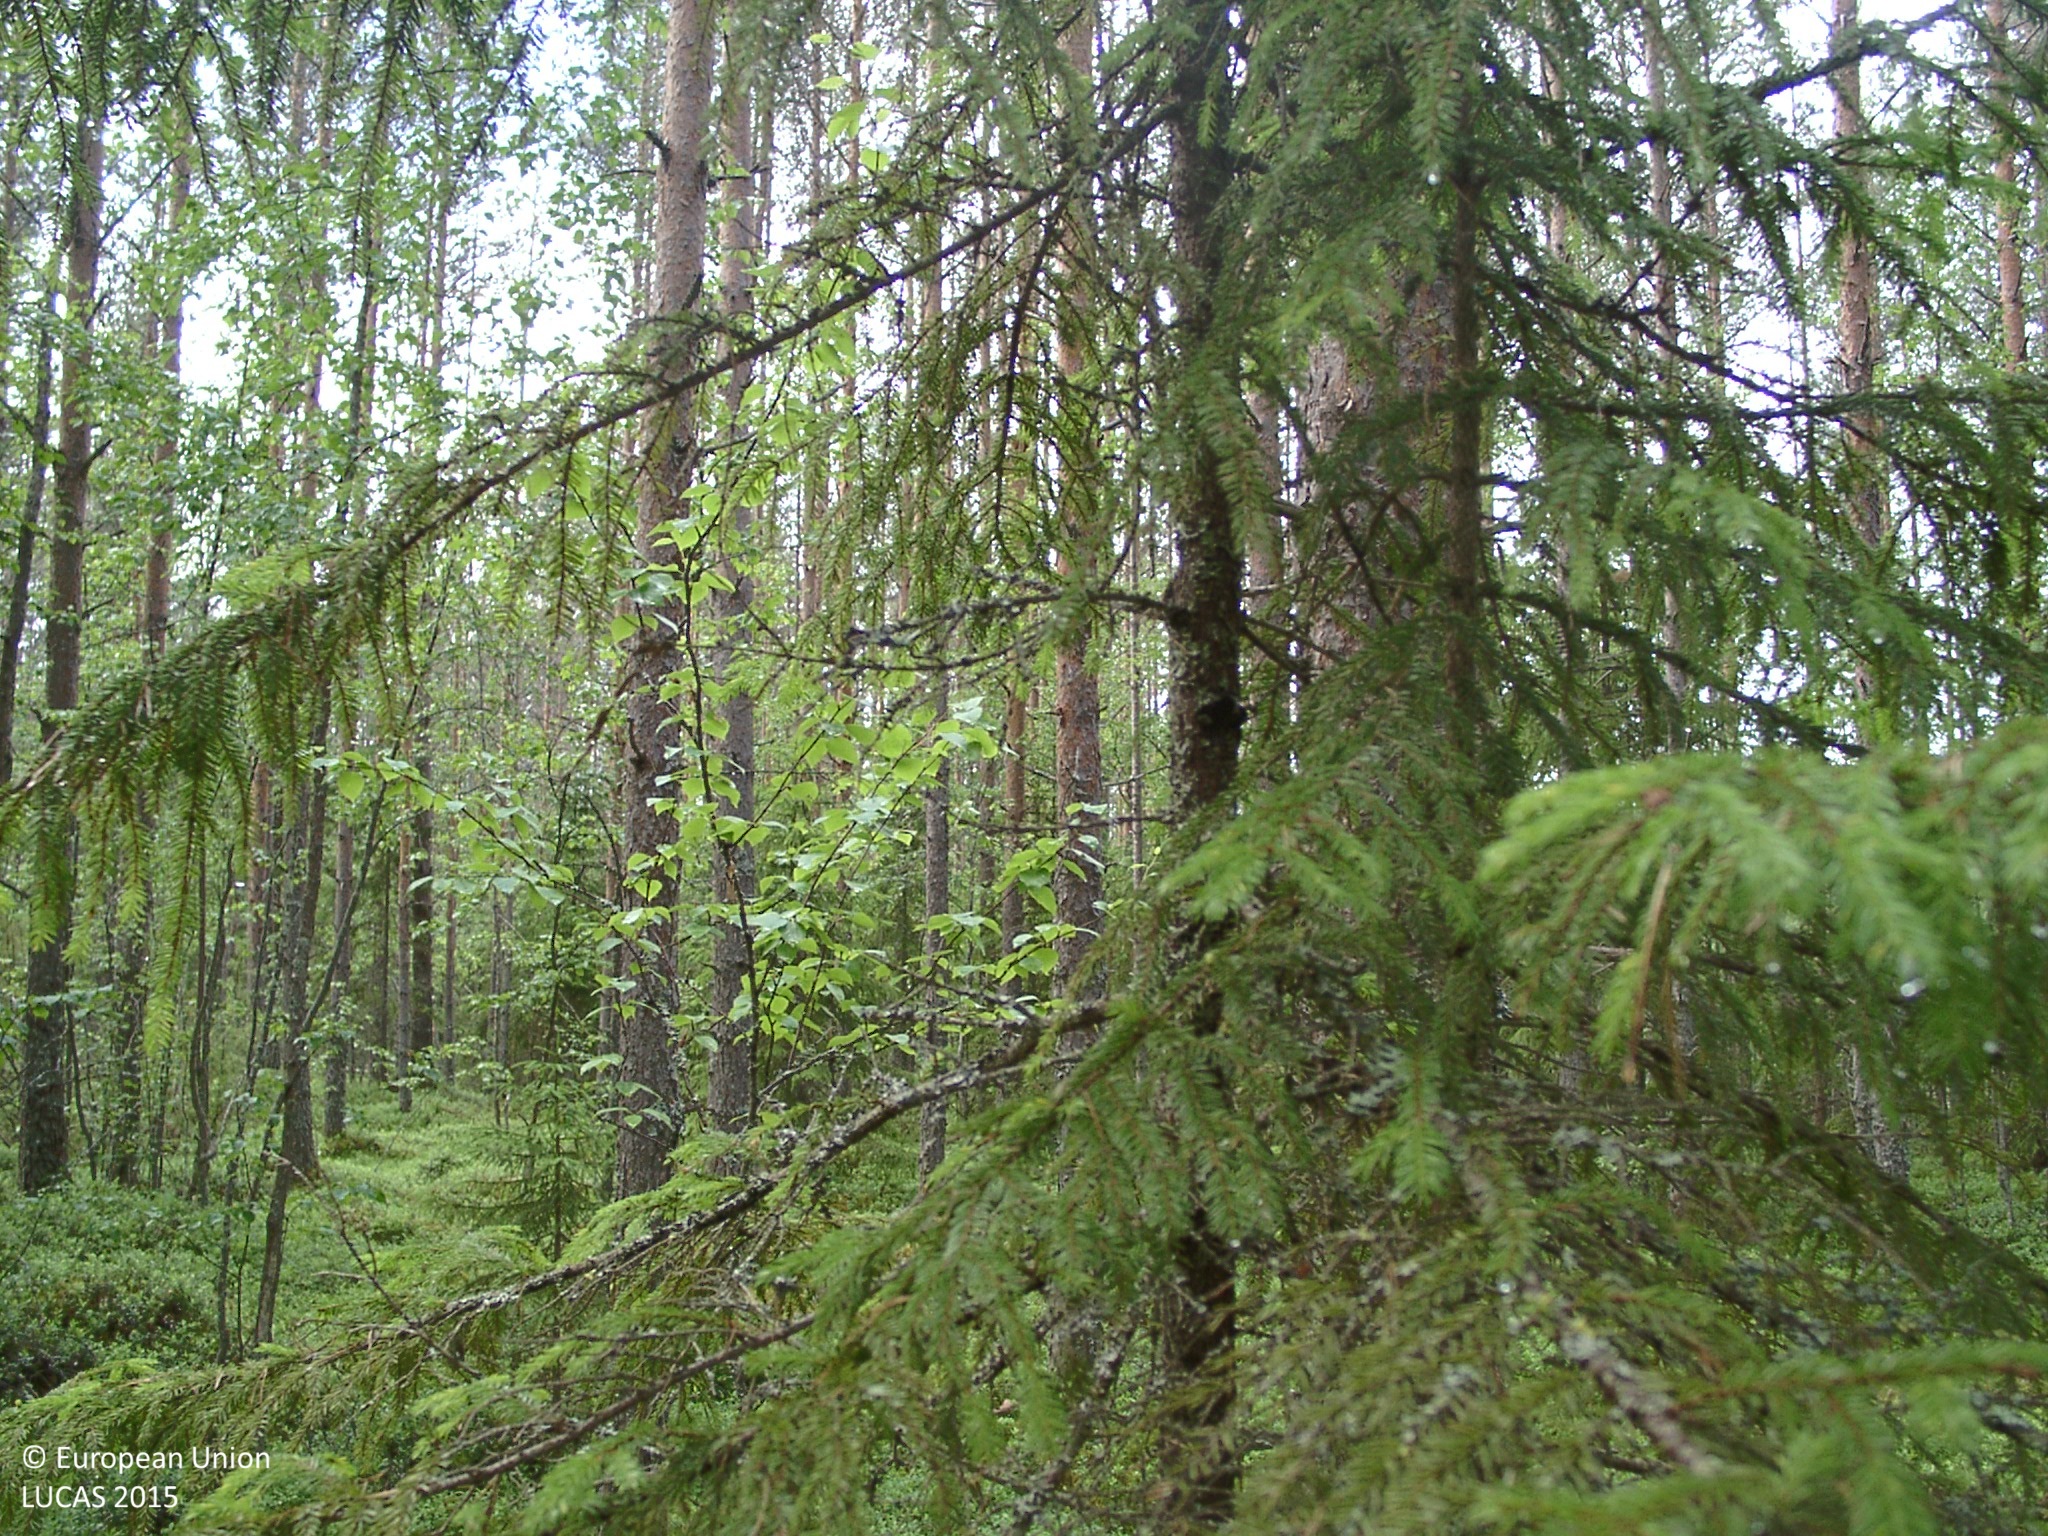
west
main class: Woodland
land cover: Other mixed woodland
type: boreal forest
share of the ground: 50 - 75 %
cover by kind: coniferous forest trees 55 %, broadleaved forest trees 20 %, shrubs 20 %, lichens and mosses 5 %
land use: Semi-natural and natural areas not in use
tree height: > 5 m
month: July
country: FI
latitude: 62.1580
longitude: 25.0955
